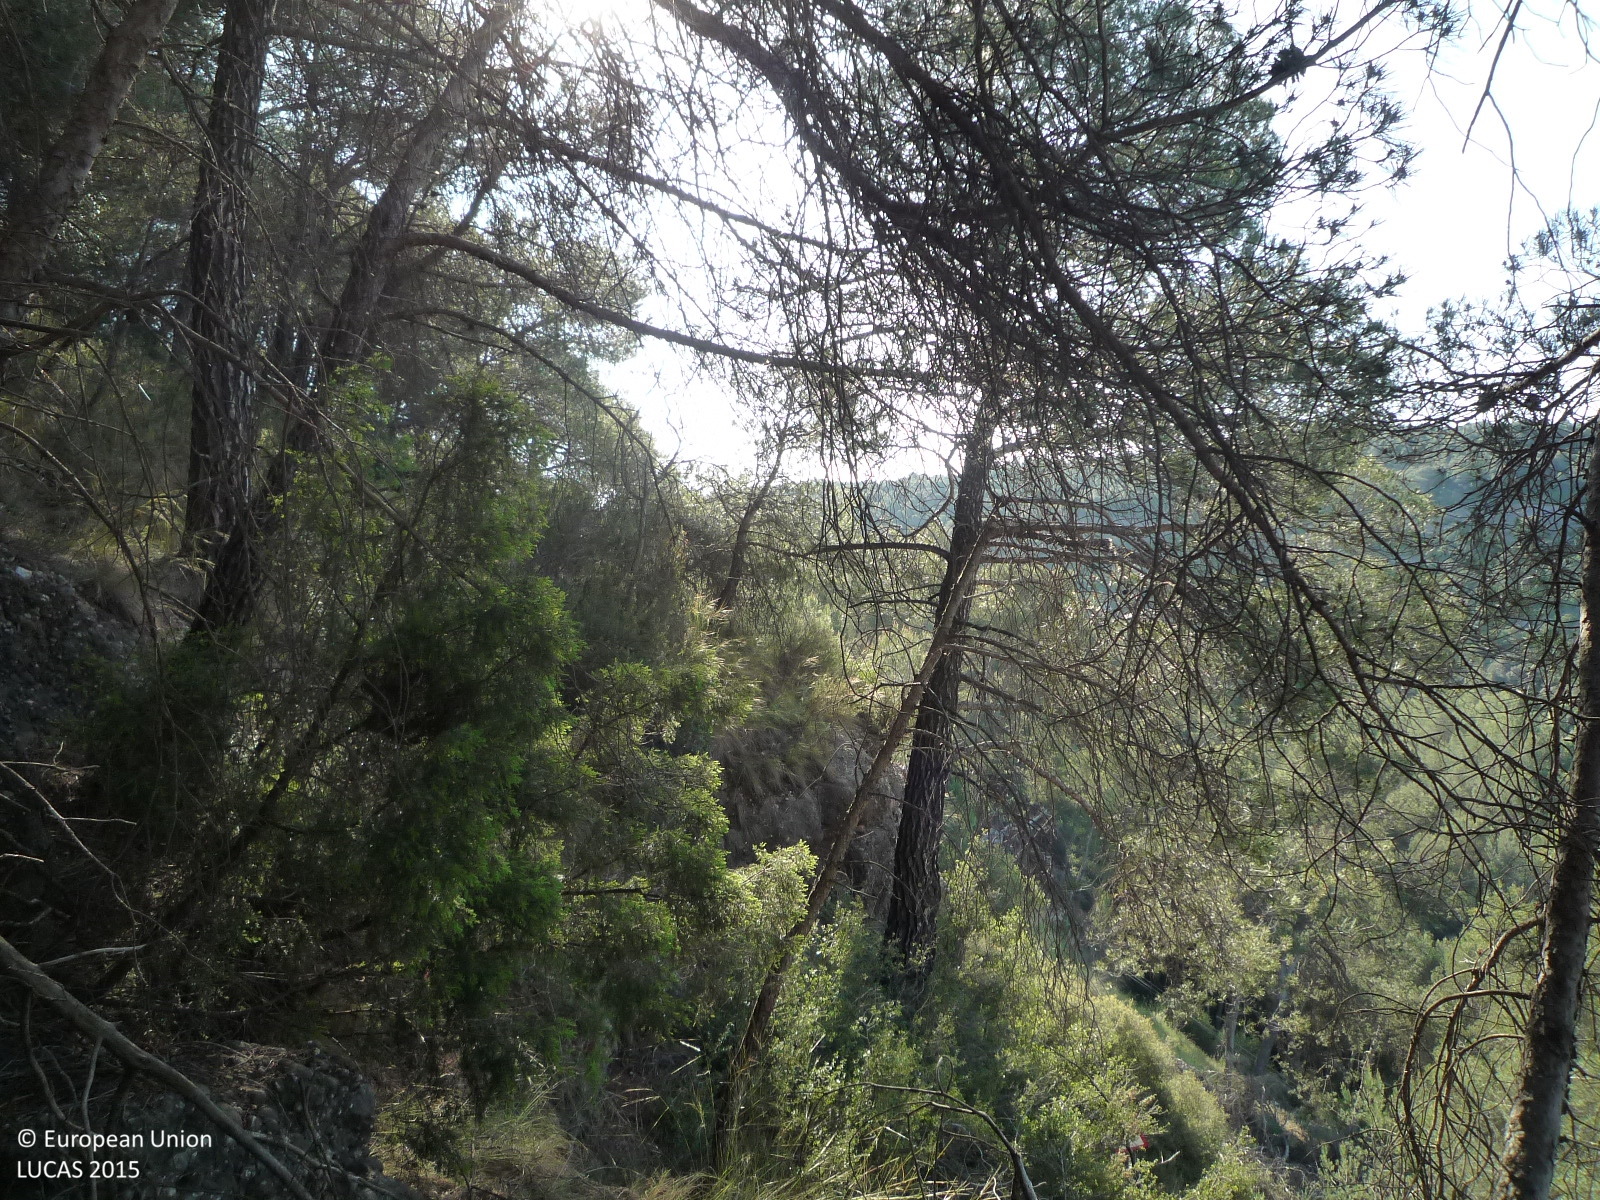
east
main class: Woodland
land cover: Pine dominated coniferous woodland
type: coniferous forest of the mediterranean region
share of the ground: > 75 %
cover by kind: coniferous forest trees 95 %, herbaceous plants 5 %
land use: Semi-natural and natural areas not in use
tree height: > 5 m
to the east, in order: Pine dominated coniferous woodland; Rock outcrops; Paved roads, cycling and walking lanes; Pine dominated coniferous woodland; Paved roads, cycling and walking lanes; Pine dominated coniferous woodland; Rock outcrops; Electric lines; Paved roads, cycling and walking lanes; Grass margins; Tracks; Grassland without tree/shrub cover; Rocks and stones; Shrubland with sparse tree cover; Inland fresh running water; Pine dominated coniferous woodland
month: May
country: ES
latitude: 41.6700
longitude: 2.0528
